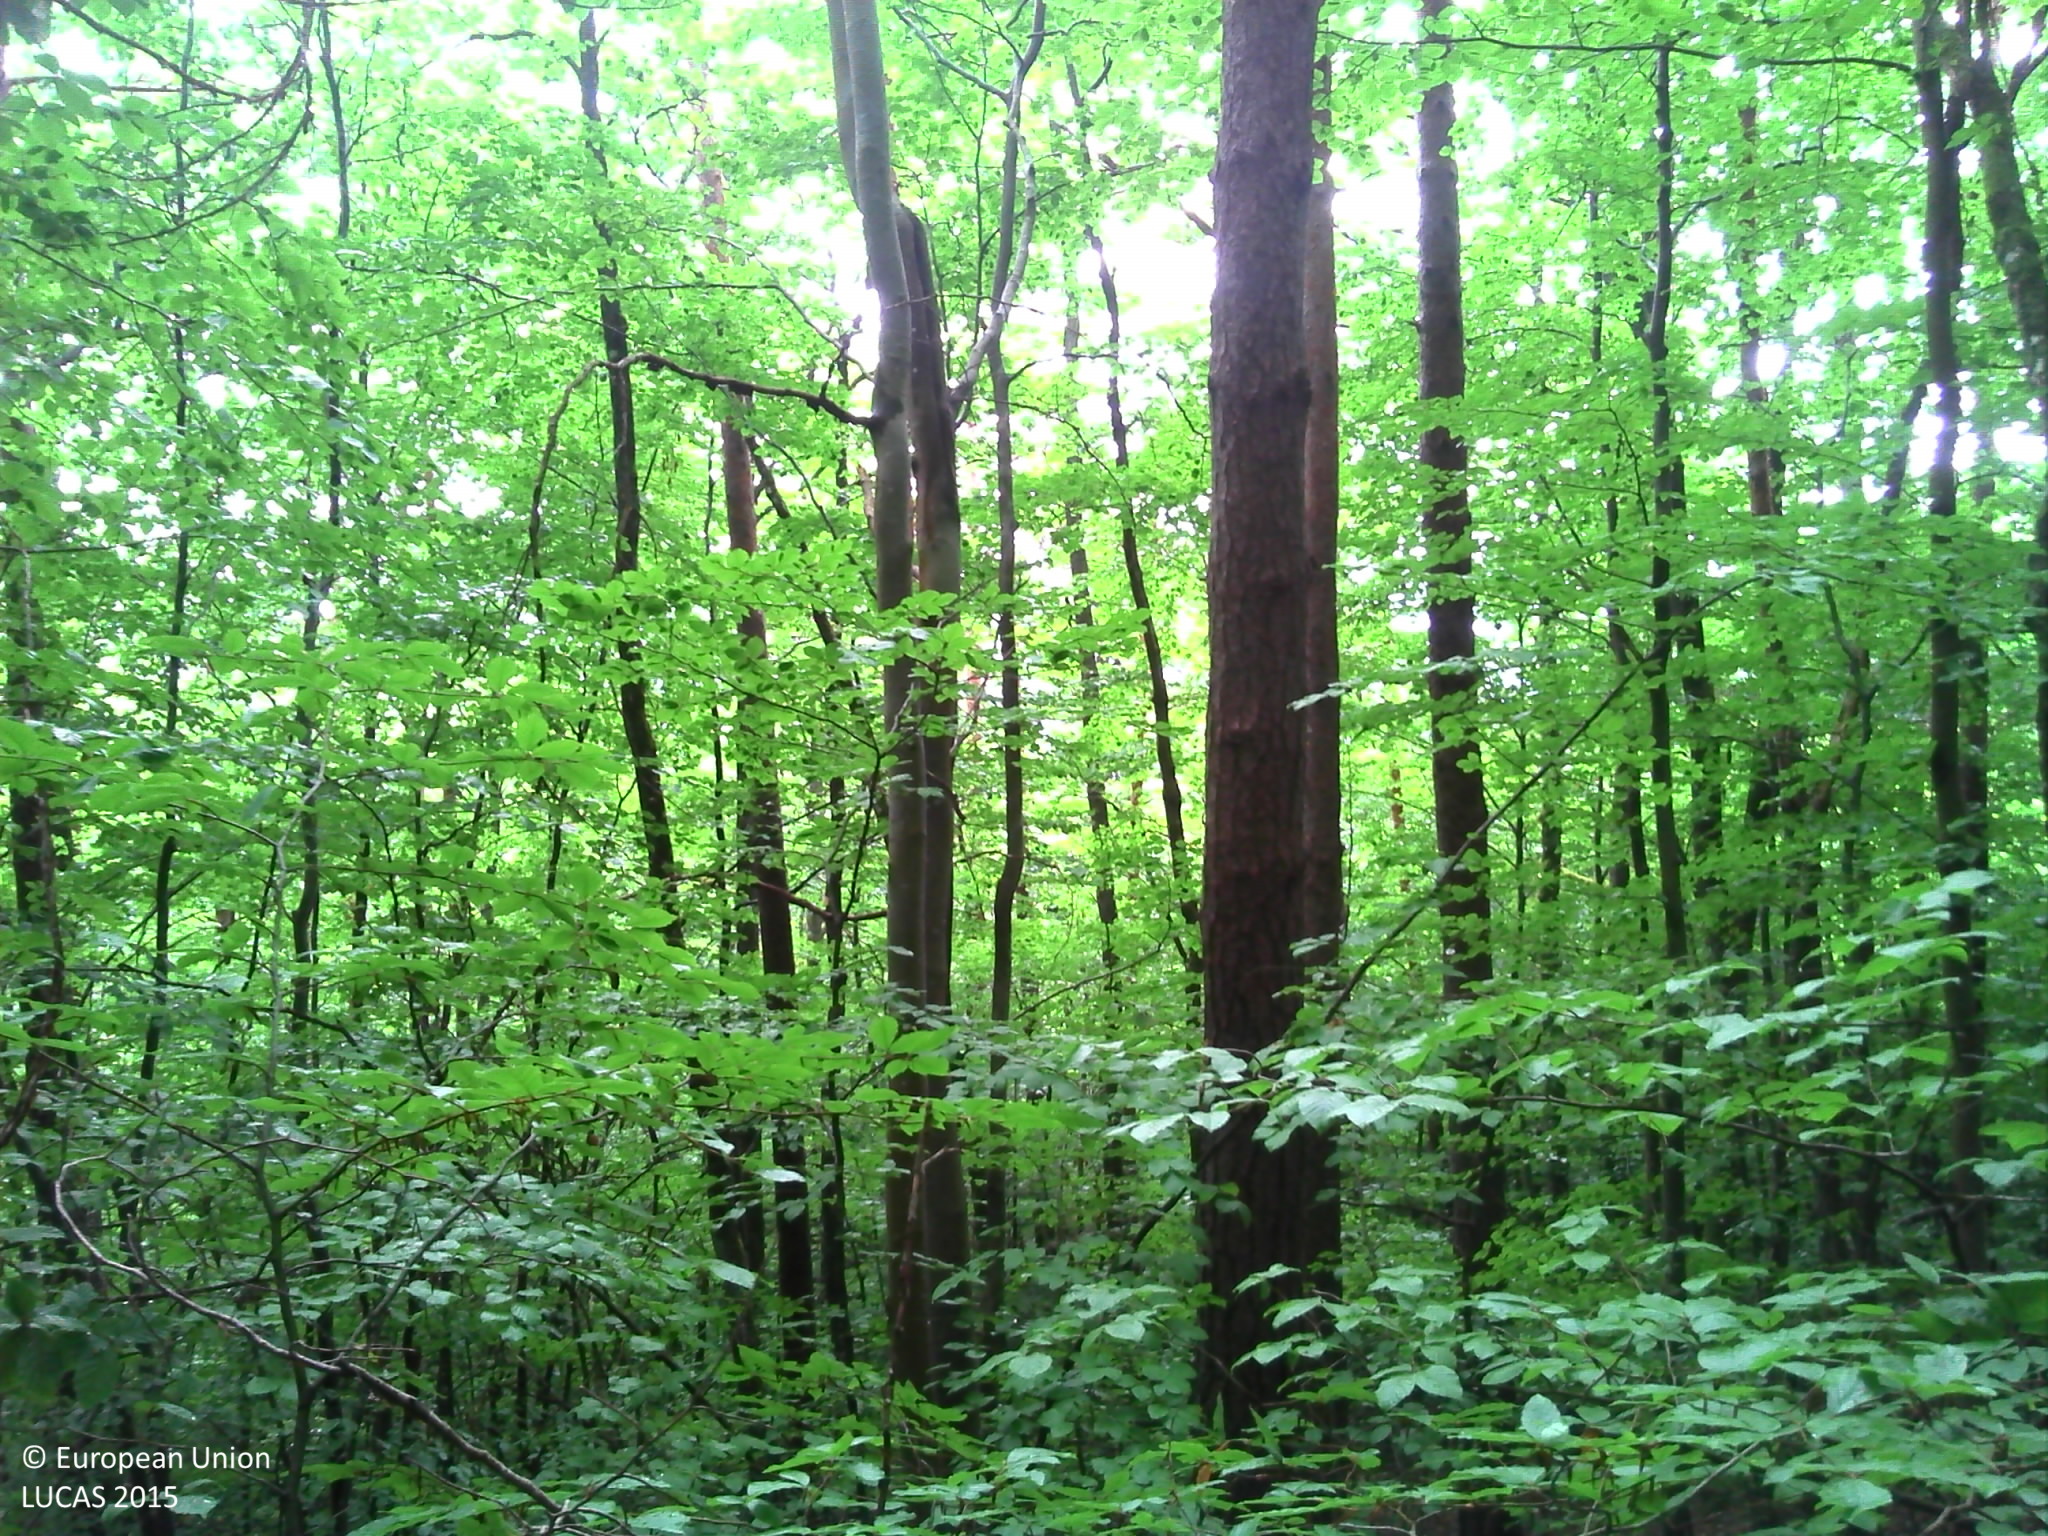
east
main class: Woodland
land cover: Spruce dominated mixed woodland
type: mountainous beech forest
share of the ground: > 75 %
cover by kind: broadleaved forest trees 60 %, coniferous forest trees 20 %, shrubs 10 %, herbaceous plants 5 %, lichens and mosses 5 %
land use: Forestry
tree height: > 5 m
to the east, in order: Spruce dominated mixed woodland; Shrubland with sparse tree cover; Electric lines; Shrubland with sparse tree cover; Spruce dominated mixed woodland; Grass margins; Paved roads, cycling and walking lanes; Grass margins; Spruce dominated mixed woodland
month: July
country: FR
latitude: 45.1983
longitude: 4.1611
